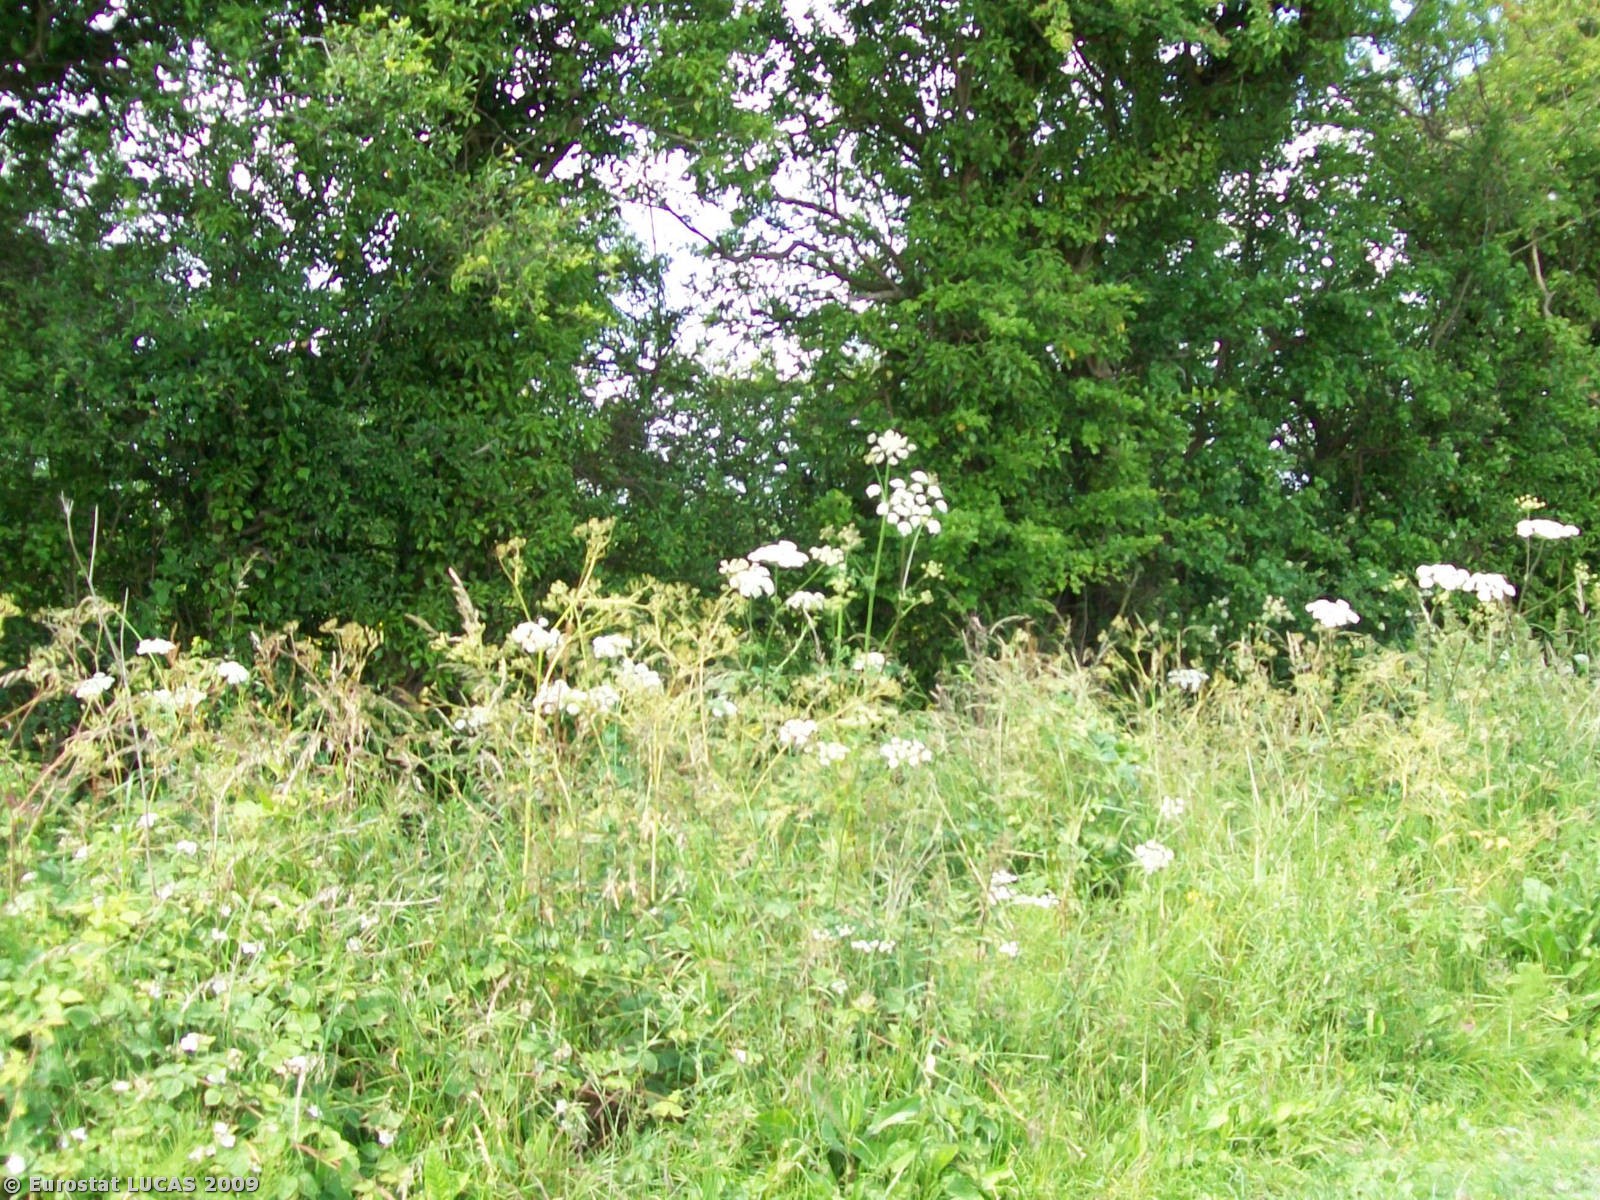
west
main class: Cropland
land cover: Common wheat
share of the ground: > 75 %
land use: Agriculture (excluding fallow land and kitchen gardens)
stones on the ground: < 10 %
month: June
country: GB
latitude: 52.1571
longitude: 0.0427
